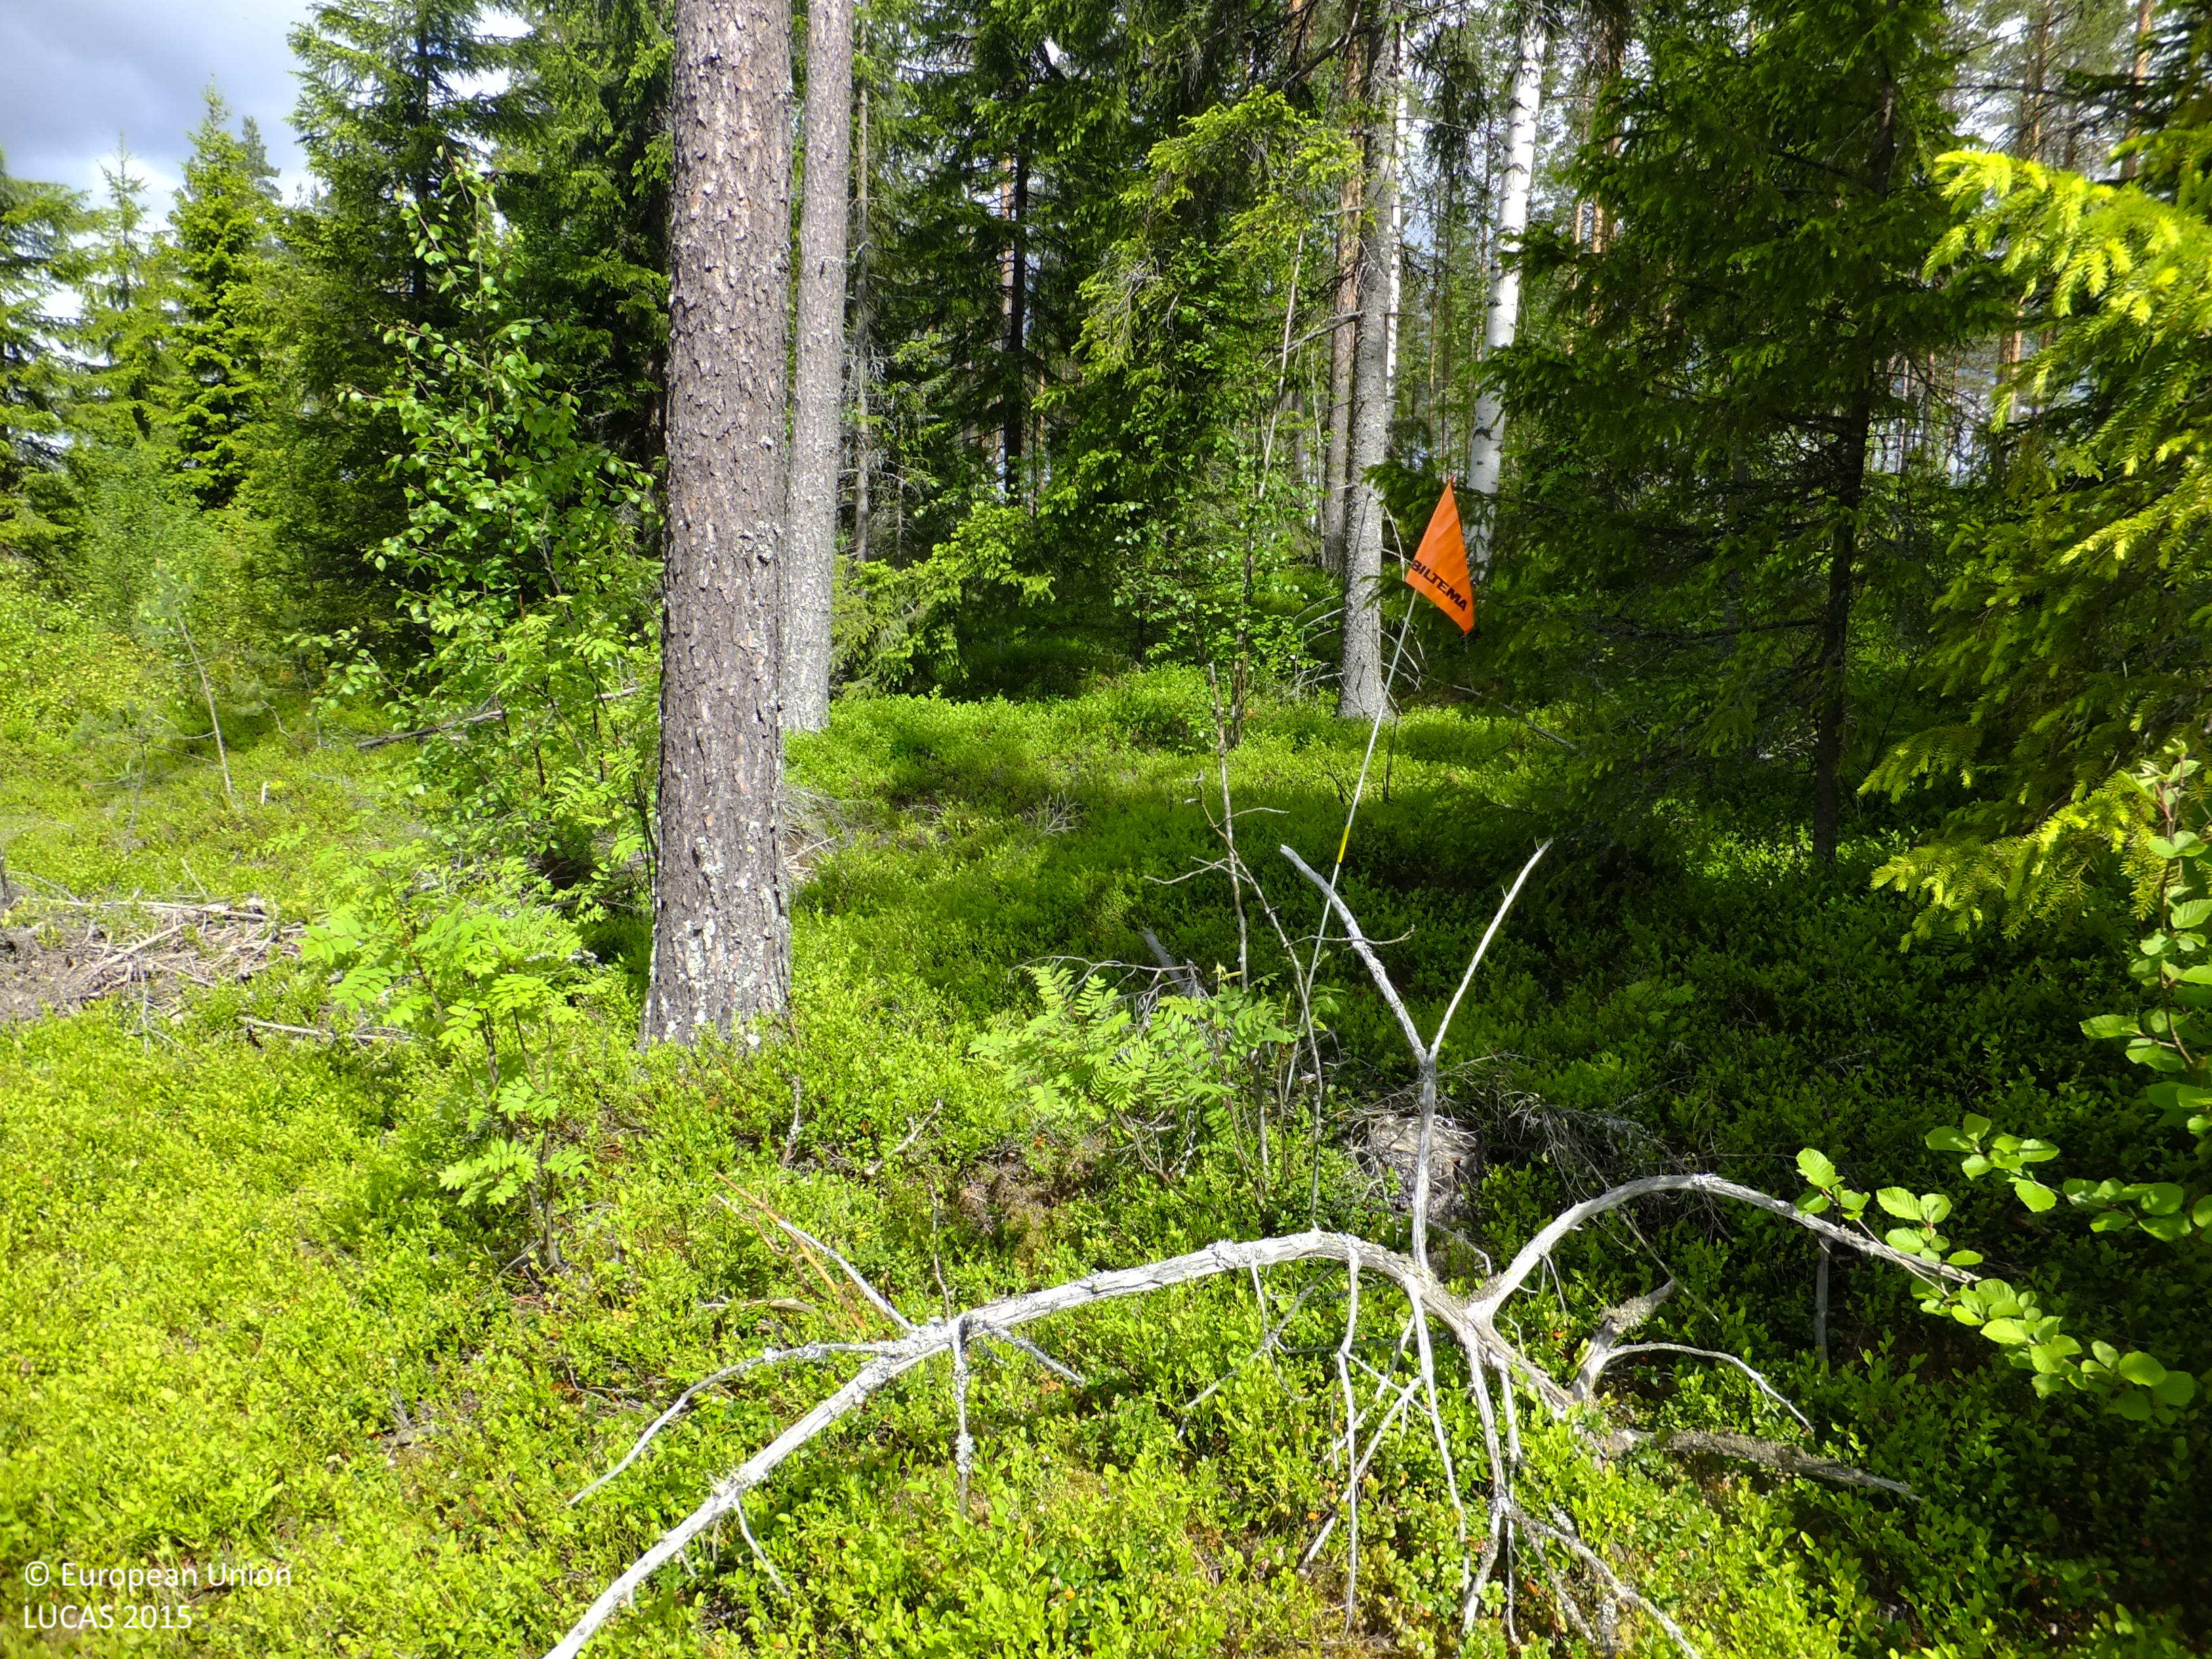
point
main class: Woodland
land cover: Other mixed woodland
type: boreal forest
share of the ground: 50 - 75 %
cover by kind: coniferous forest trees 50 %, shrubs 30 %, broadleaved forest trees 20 %
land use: Forestry
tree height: > 5 m
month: June
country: FI
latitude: 63.5692
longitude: 24.8052
